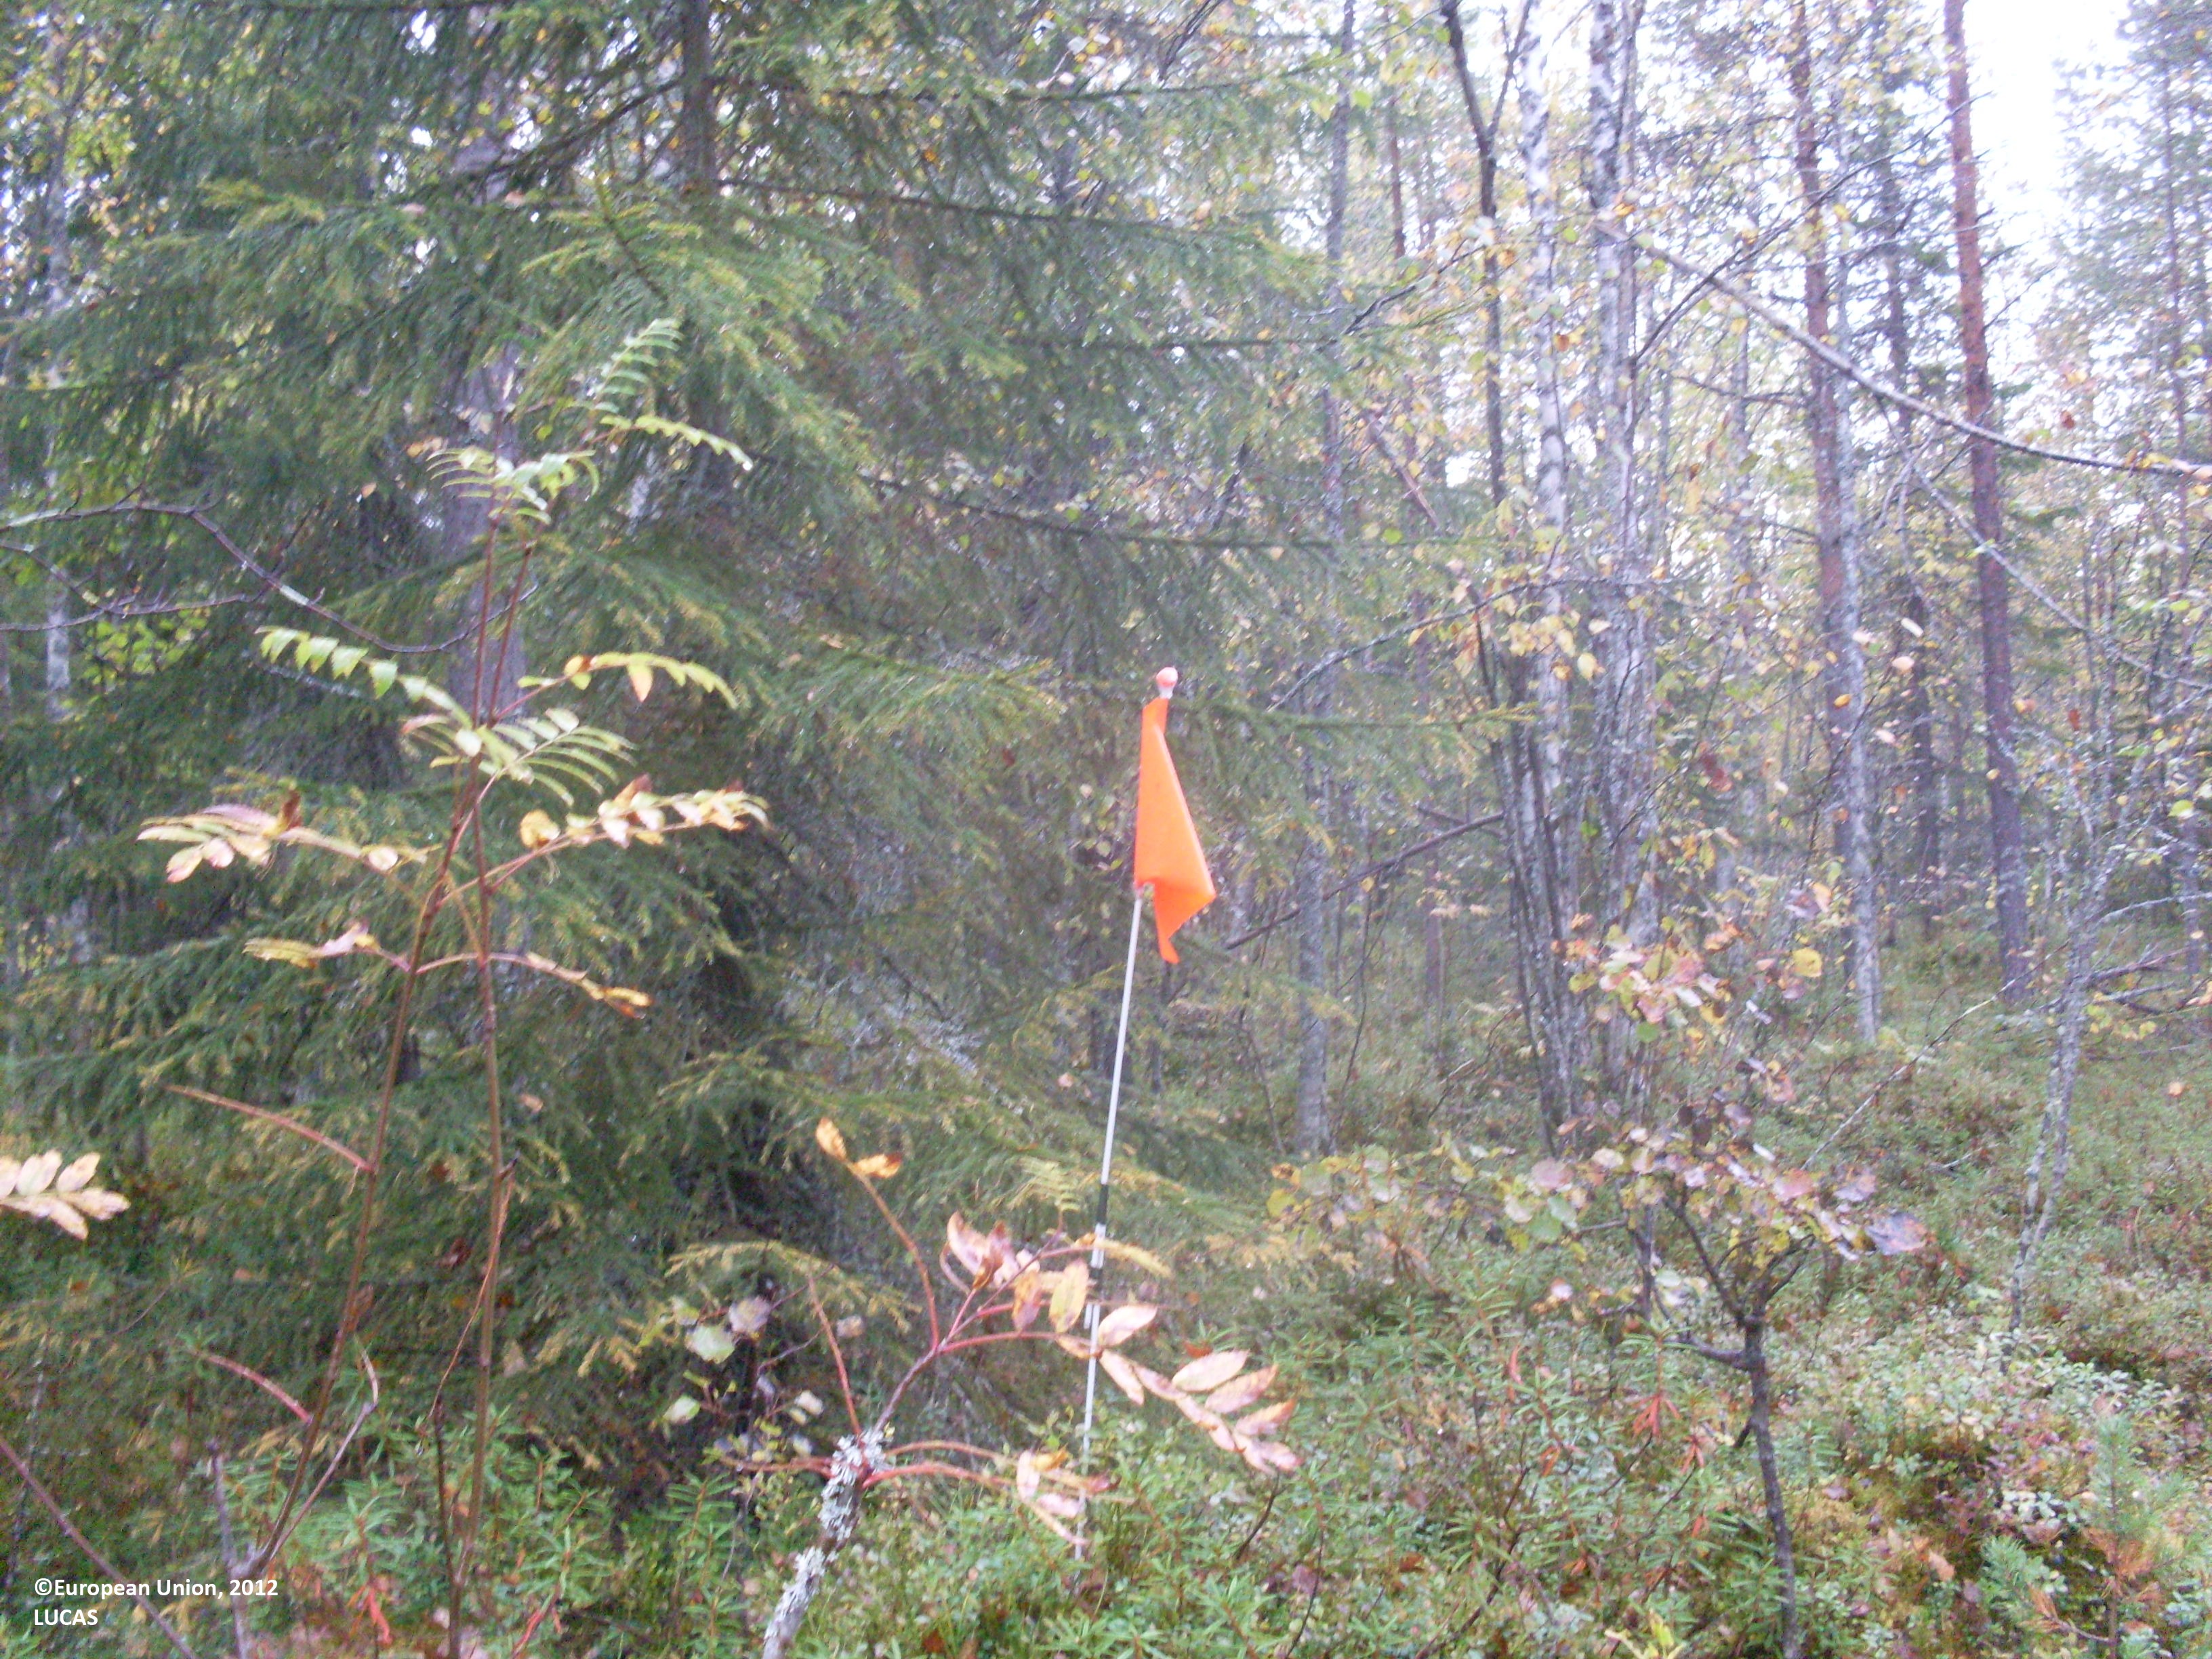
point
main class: Woodland
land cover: Other mixed woodland
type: boreal forest
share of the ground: > 75 %
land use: Forestry
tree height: > 5 m
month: September
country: FI
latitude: 64.0336
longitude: 29.9088
